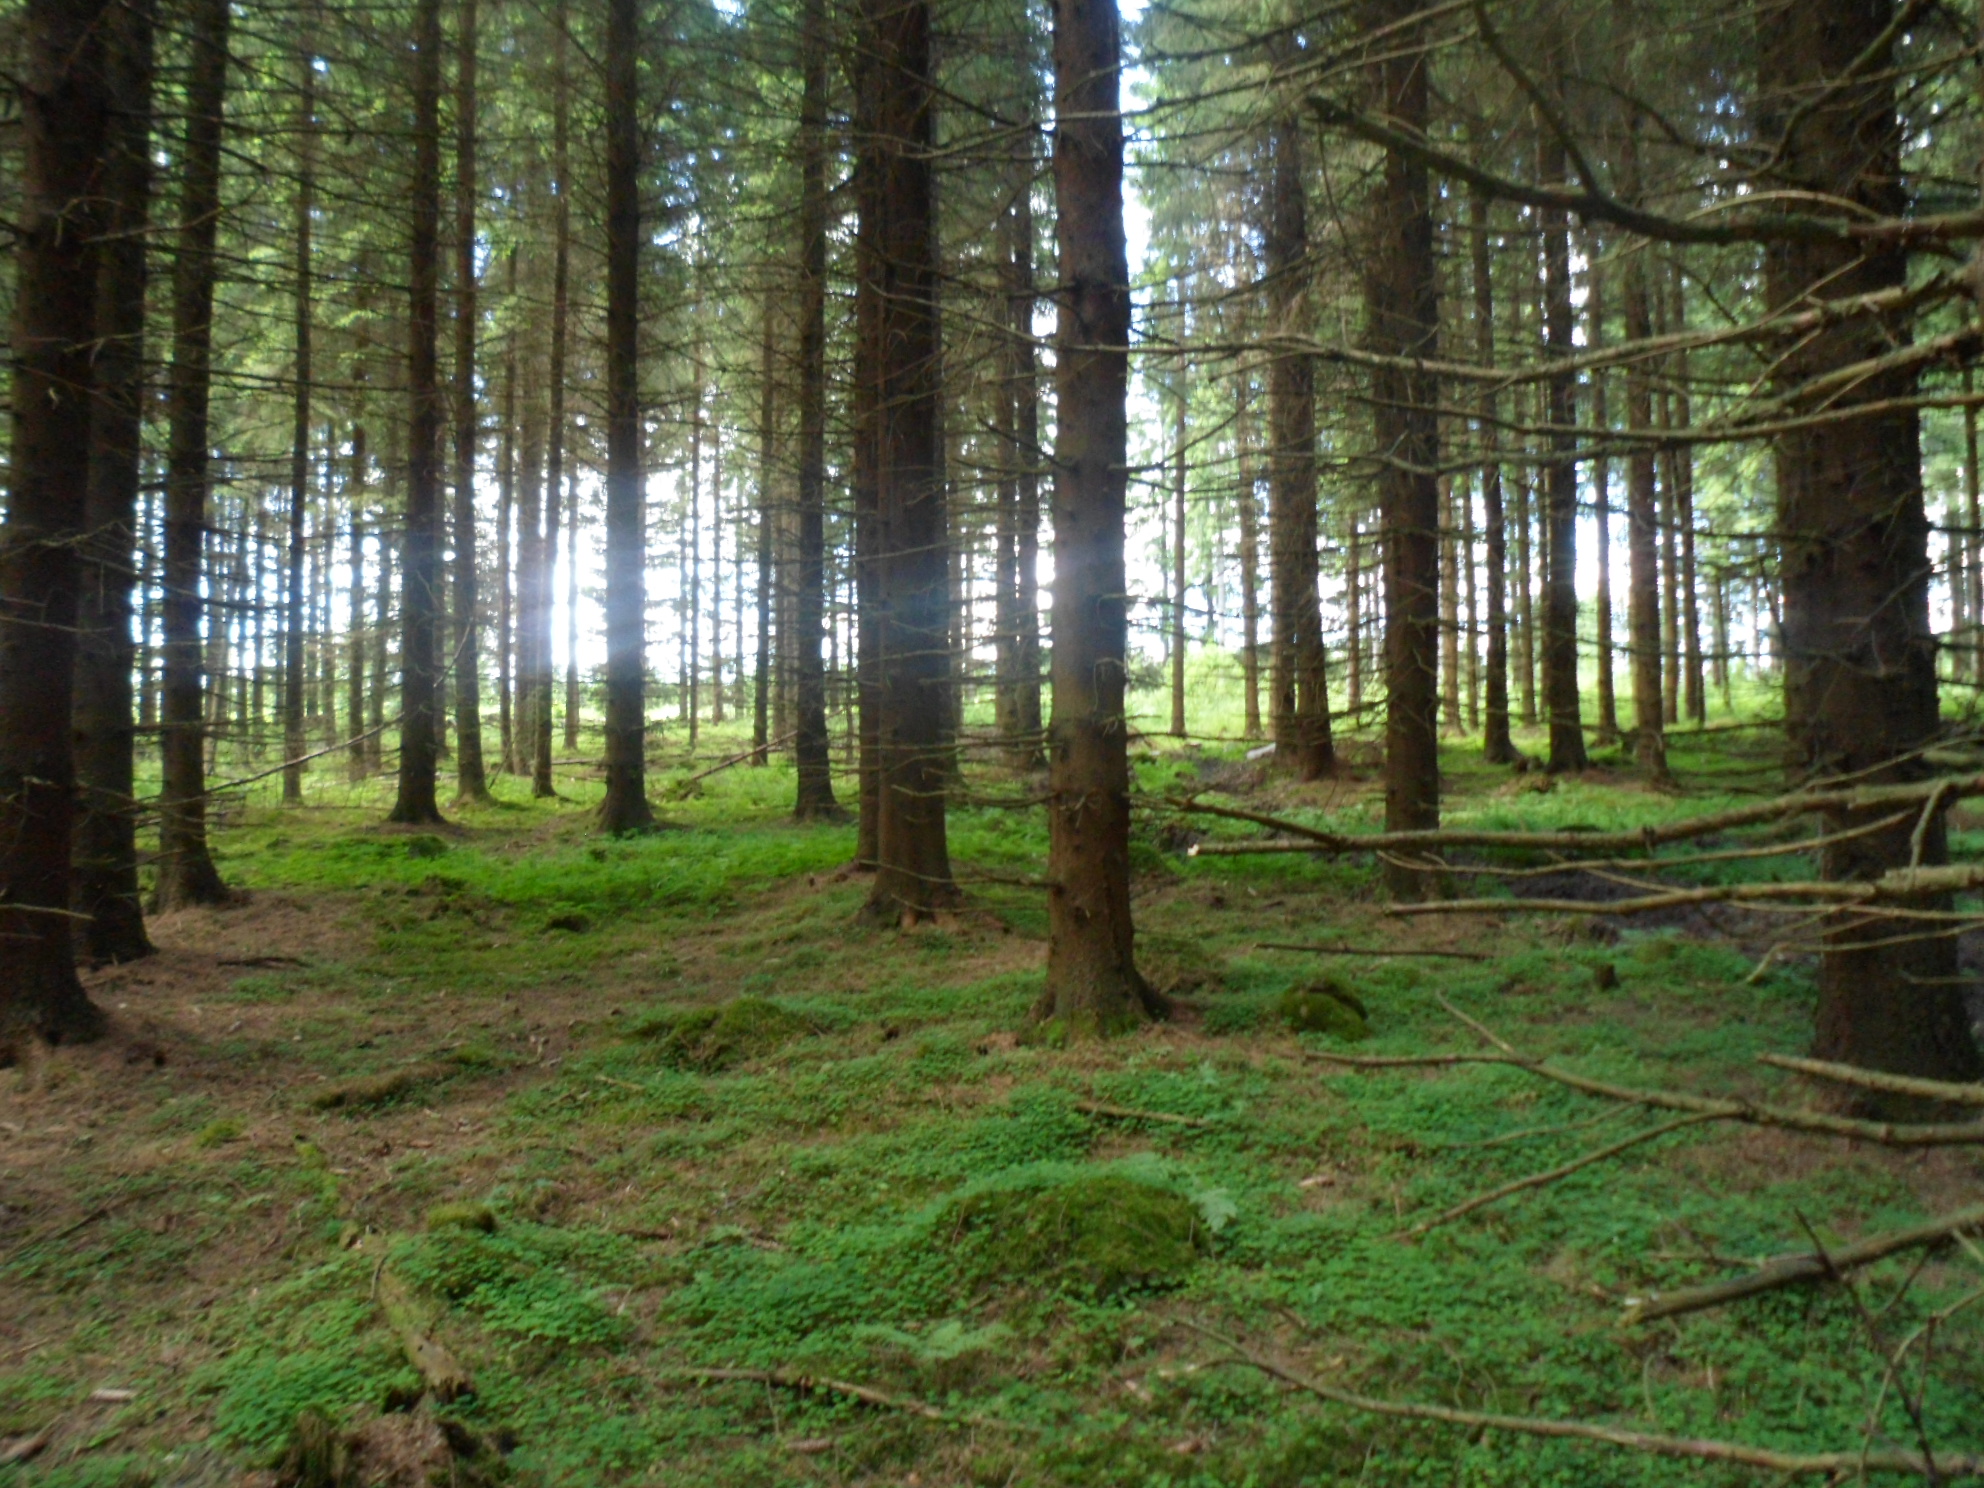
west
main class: Woodland
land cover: Spruce dominated coniferous woodland
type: boreal forest
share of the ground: > 75 %
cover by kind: coniferous forest trees 80 %, herbaceous plants 10 %, lichens and mosses 5 %, unconsolidated bare surface 5 %
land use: Forestry
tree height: > 5 m
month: July
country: SE
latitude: 57.4413
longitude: 14.5108
